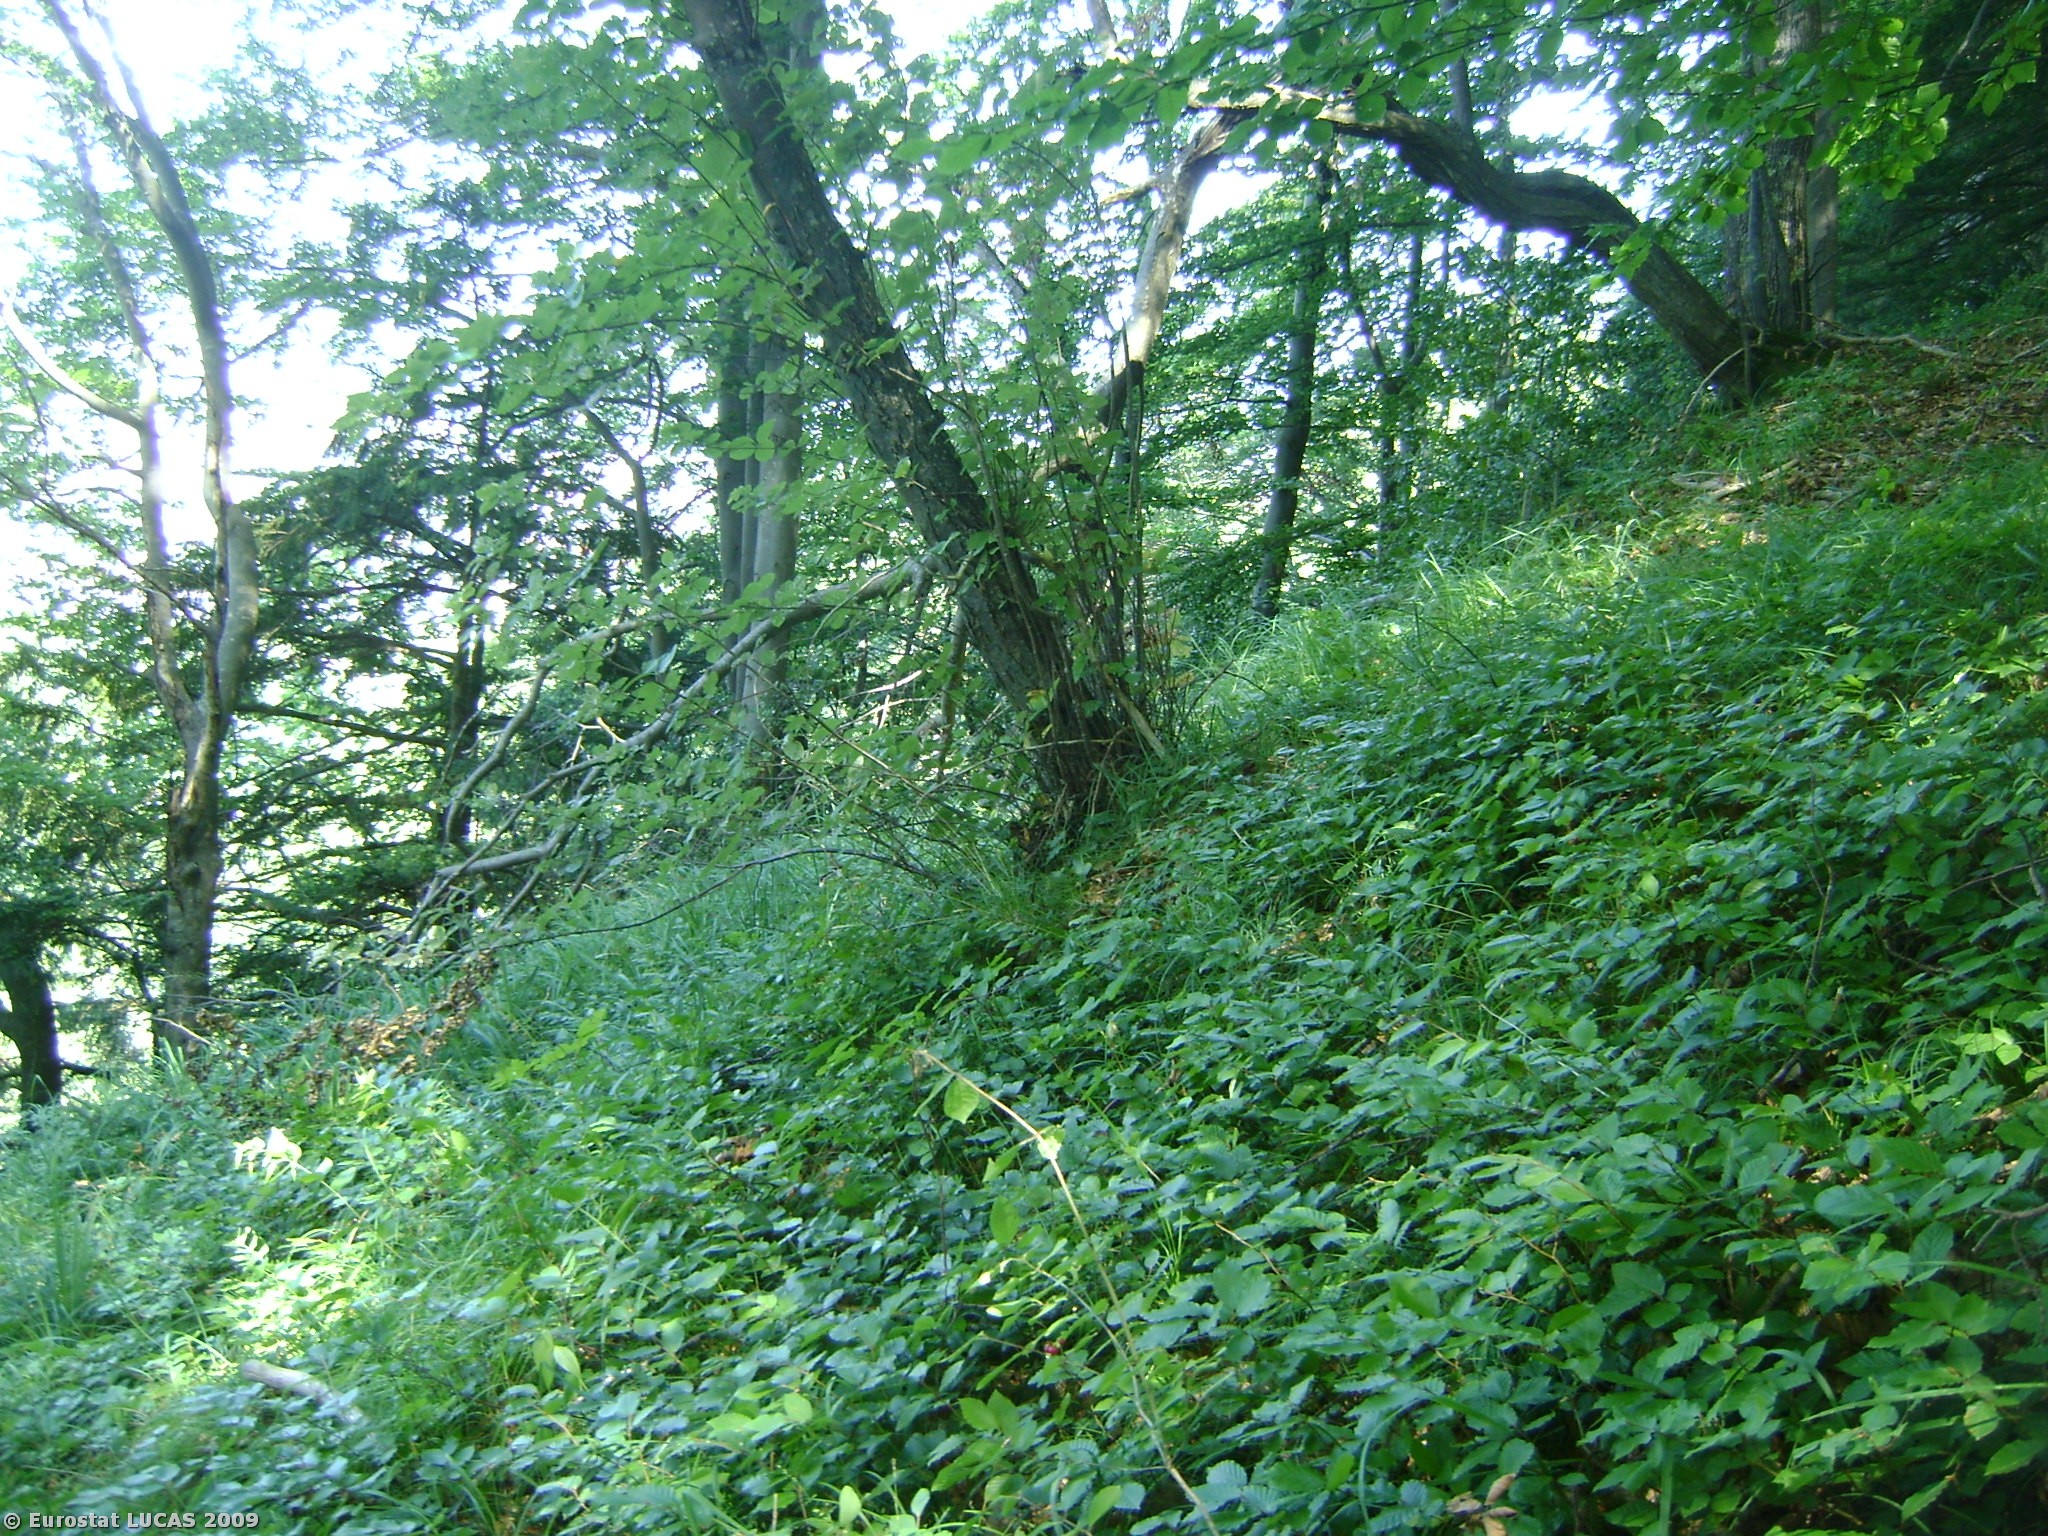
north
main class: Woodland
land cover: Broadleaved woodland
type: beech forest
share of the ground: > 75 %
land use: Forestry
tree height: > 5 m
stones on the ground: < 10 %
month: July
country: AT
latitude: 47.3411
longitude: 9.6694
